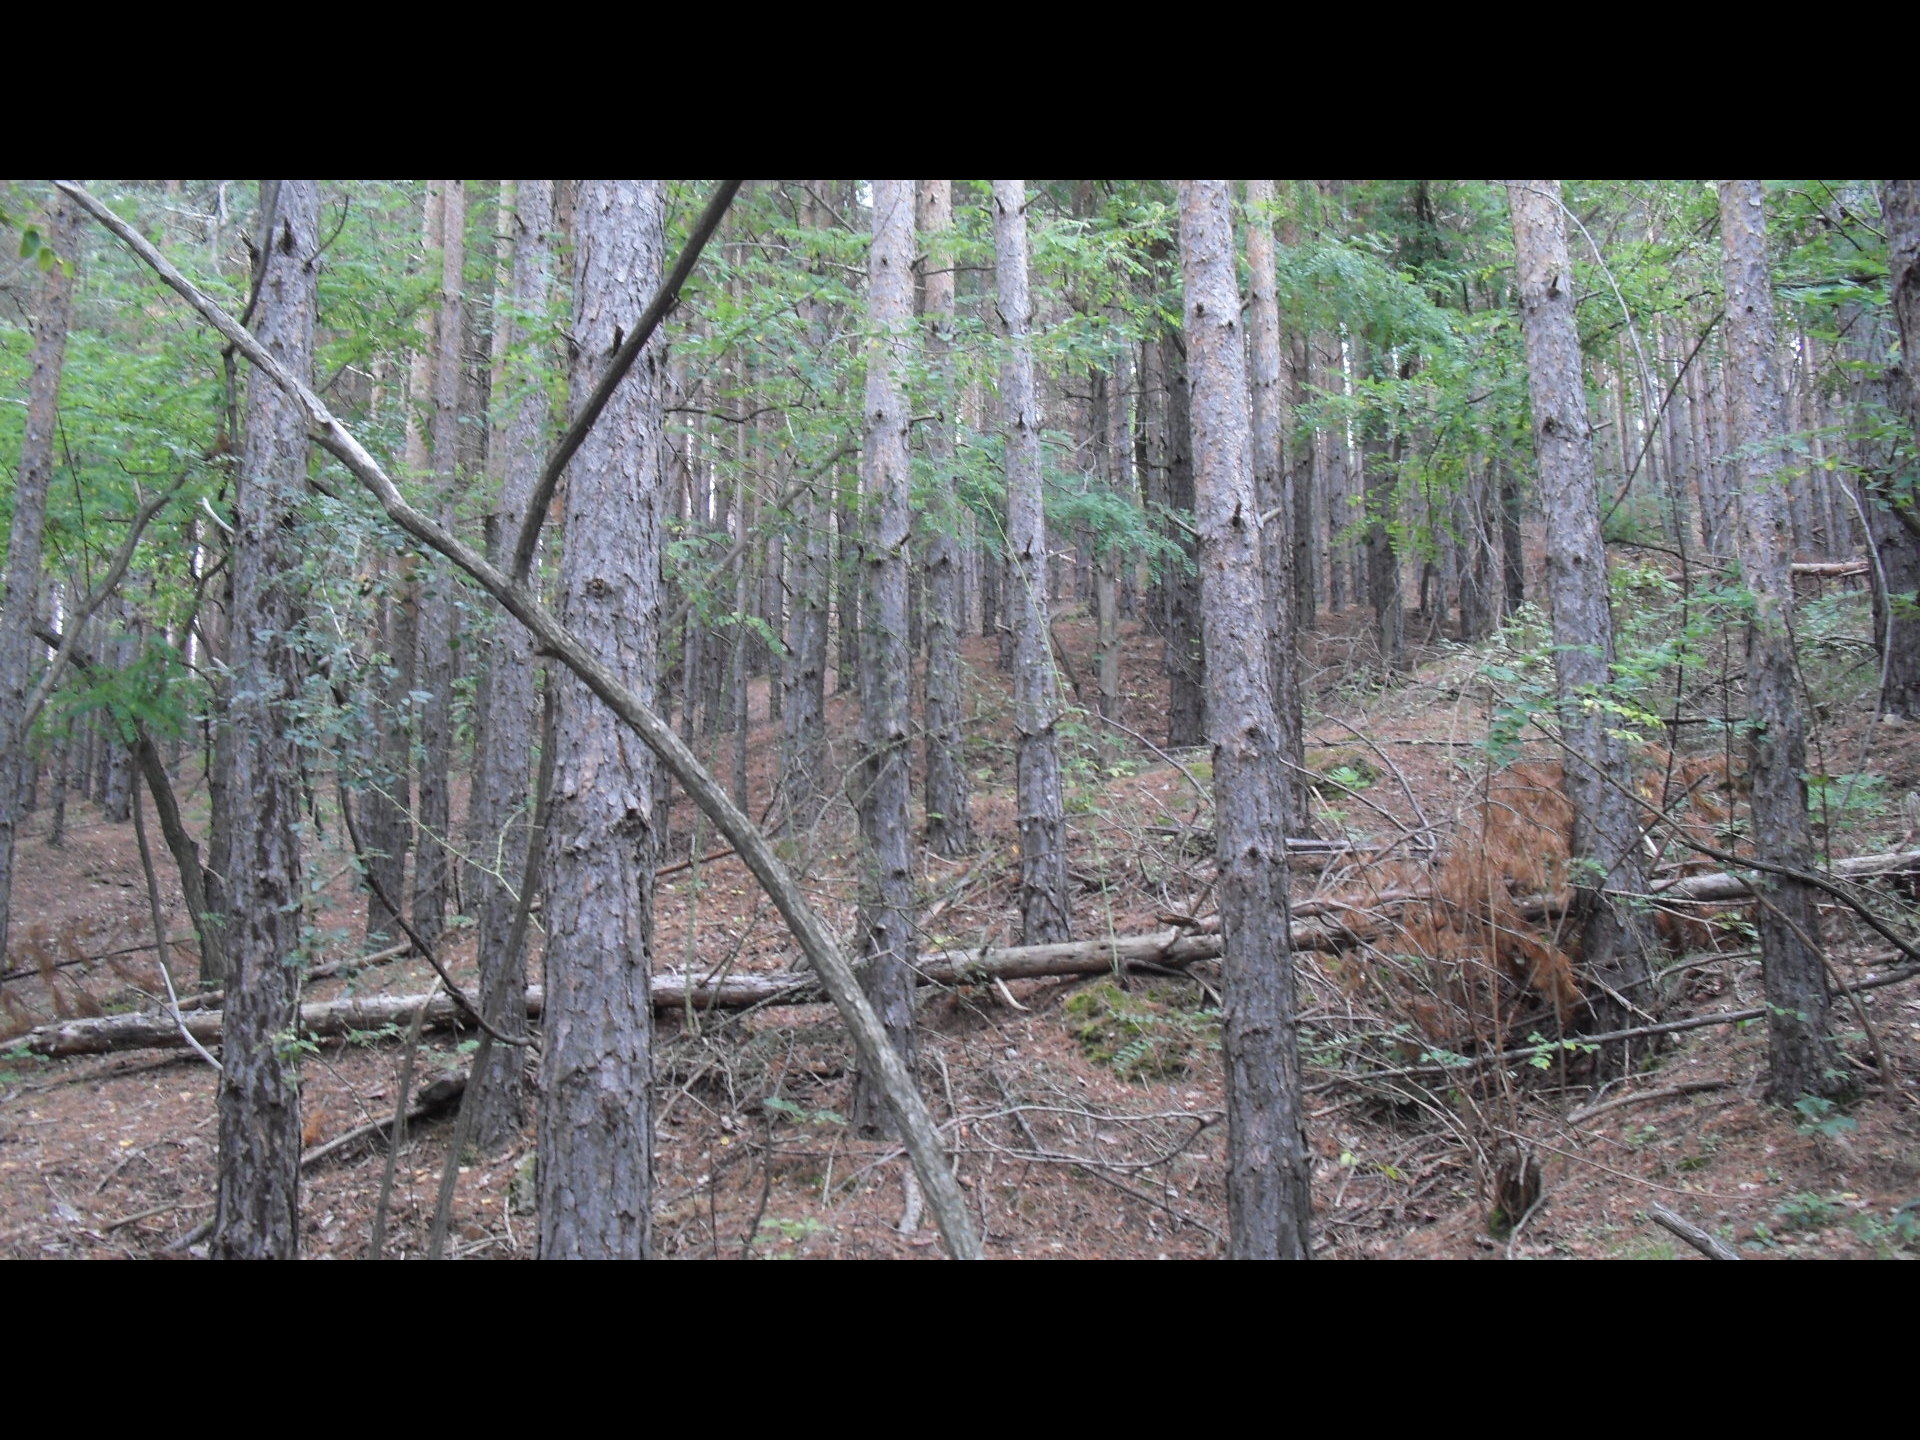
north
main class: Woodland
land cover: Other mixed woodland
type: hemiboreal forest and nemoral coniferous forest and mixed broadleaved-coniferous forest
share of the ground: > 75 %
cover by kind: coniferous forest trees 75 %, broadleaved forest trees 25 %
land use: Forestry
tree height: > 5 m
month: October
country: BG
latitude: 43.4033
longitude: 22.8387
